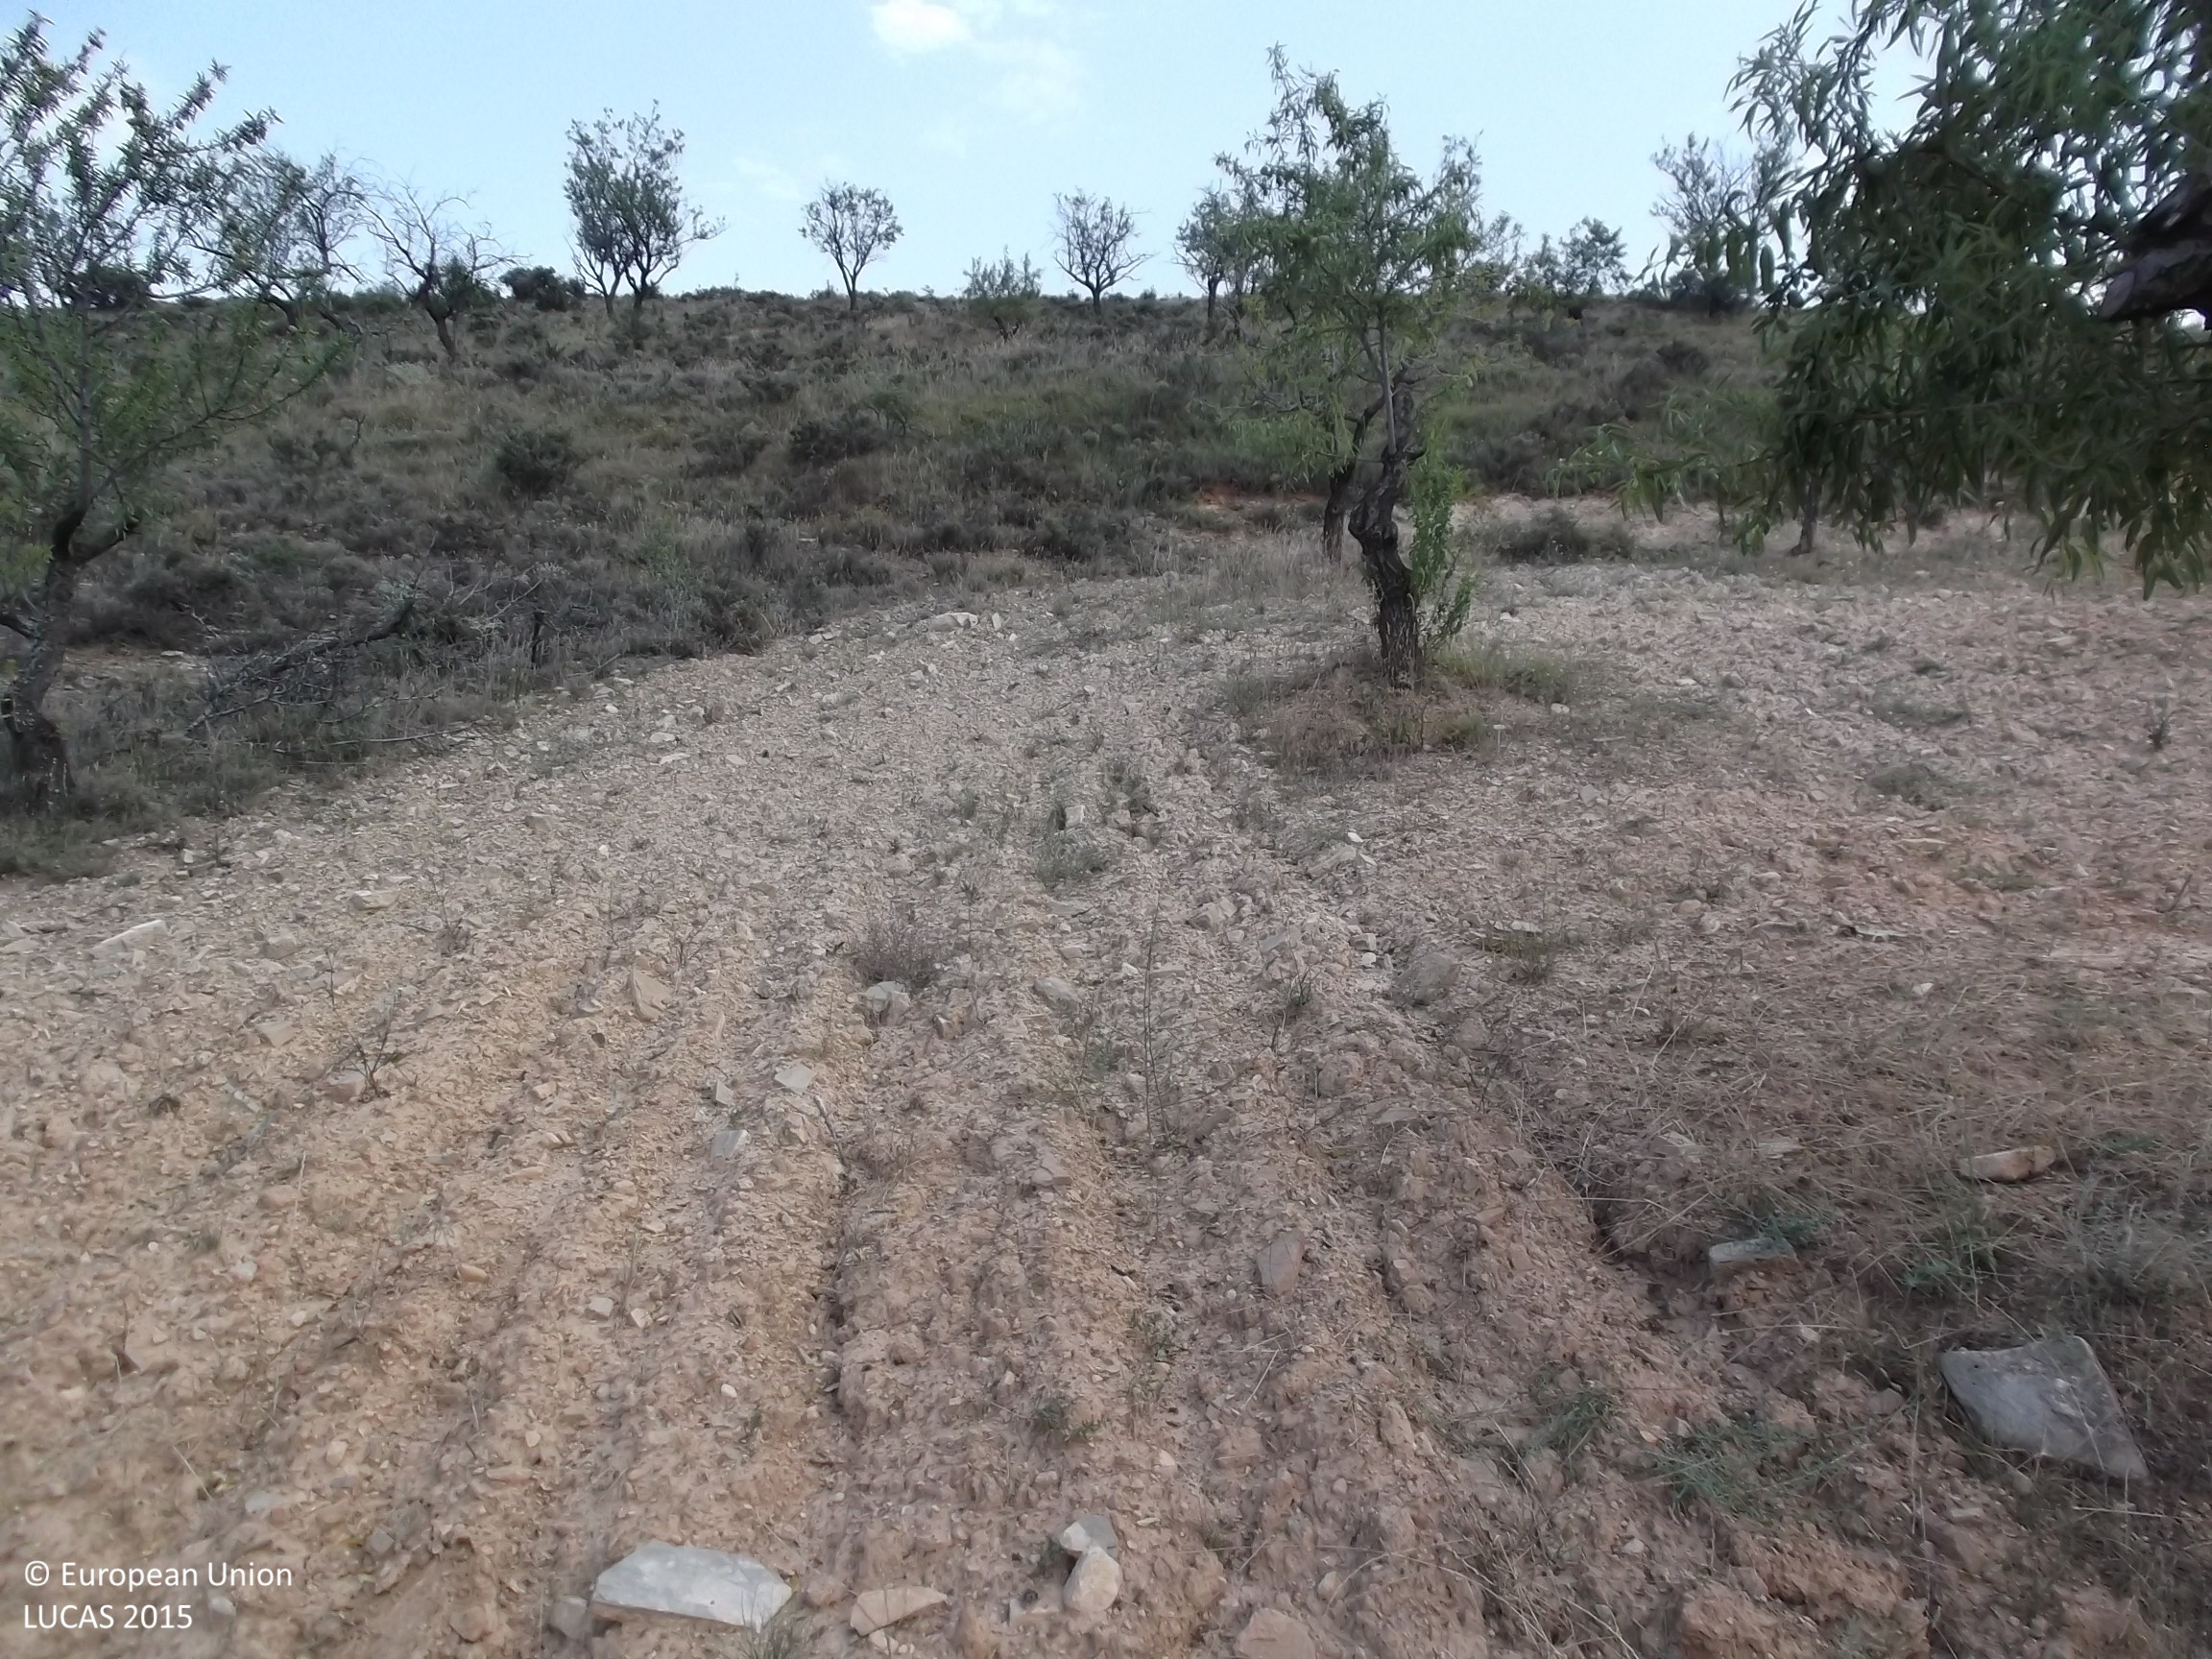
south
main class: Cropland
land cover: Nuts trees
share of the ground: 25 - 50 %
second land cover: Other bare soil
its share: > 75 %
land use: Agriculture (excluding fallow land and kitchen gardens)
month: July
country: ES
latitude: 42.0641
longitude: -2.0121
